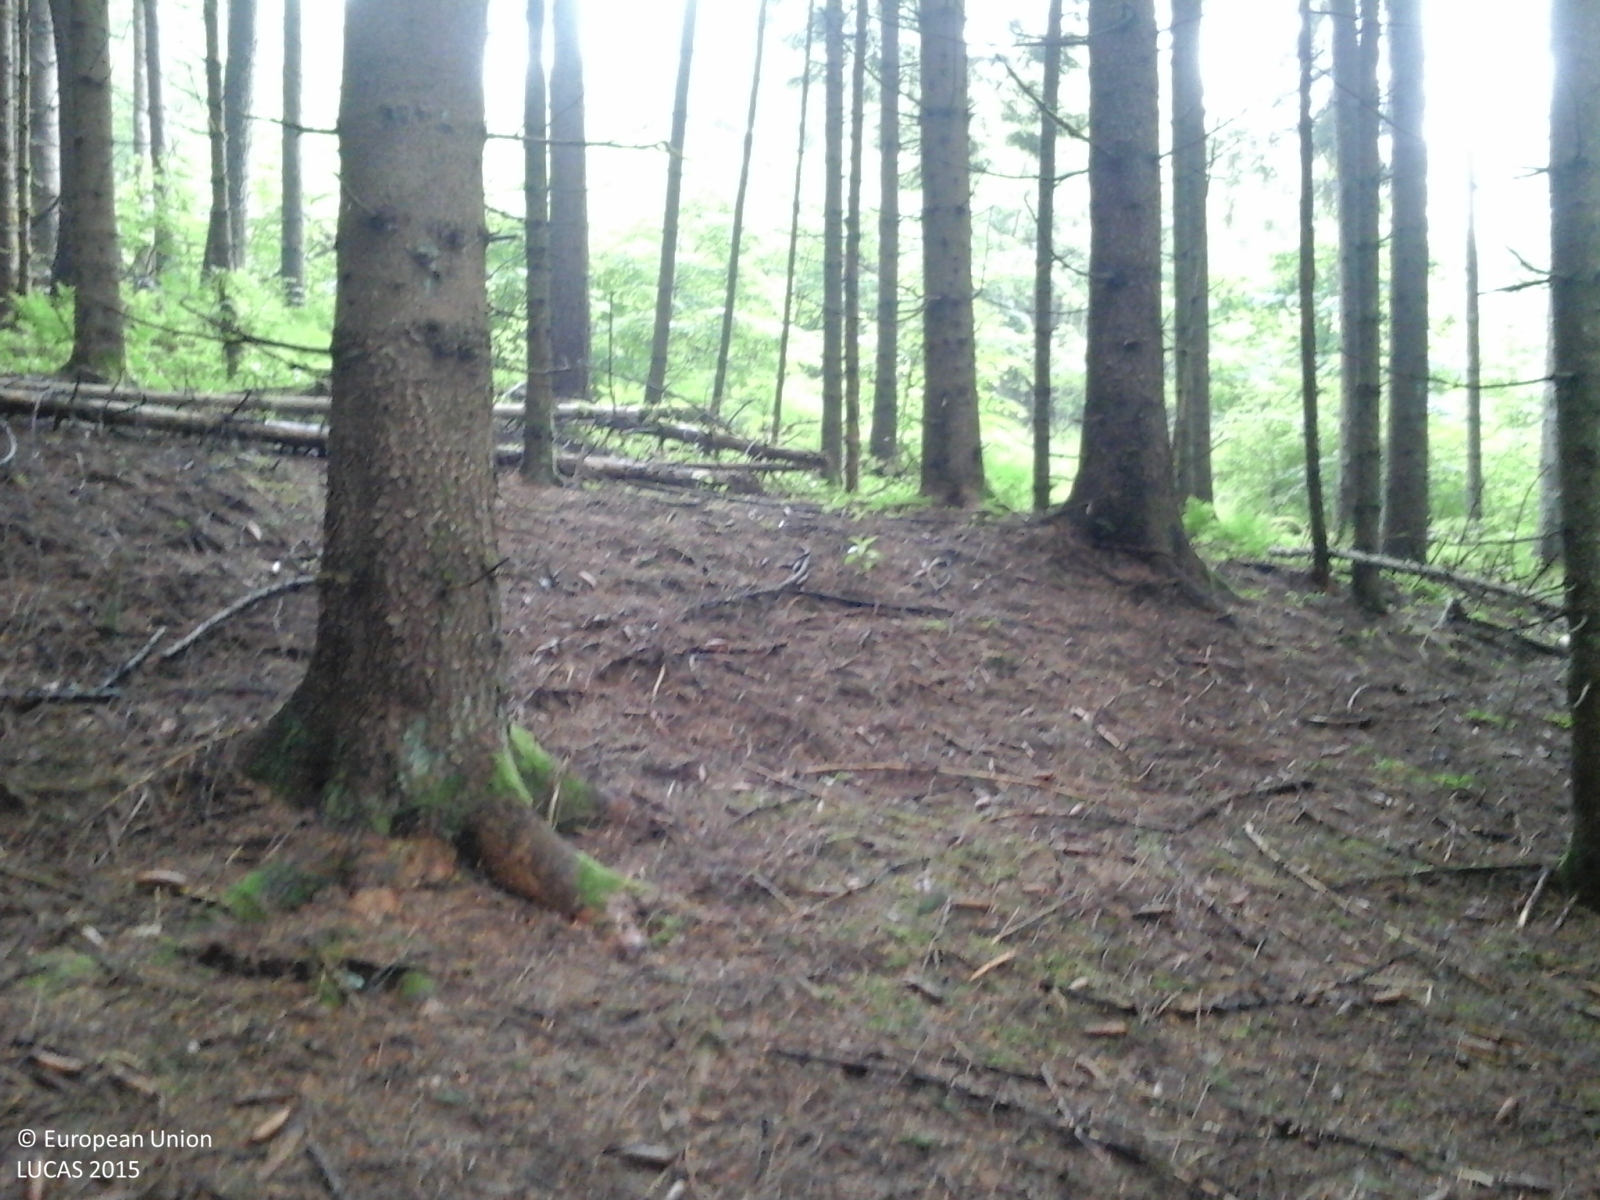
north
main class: Woodland
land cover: Spruce dominated coniferous woodland
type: alpine coniferous forest
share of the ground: > 75 %
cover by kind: coniferous forest trees 100 %
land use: Forestry
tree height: > 5 m
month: May
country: IT
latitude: 46.0328
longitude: 11.6128
